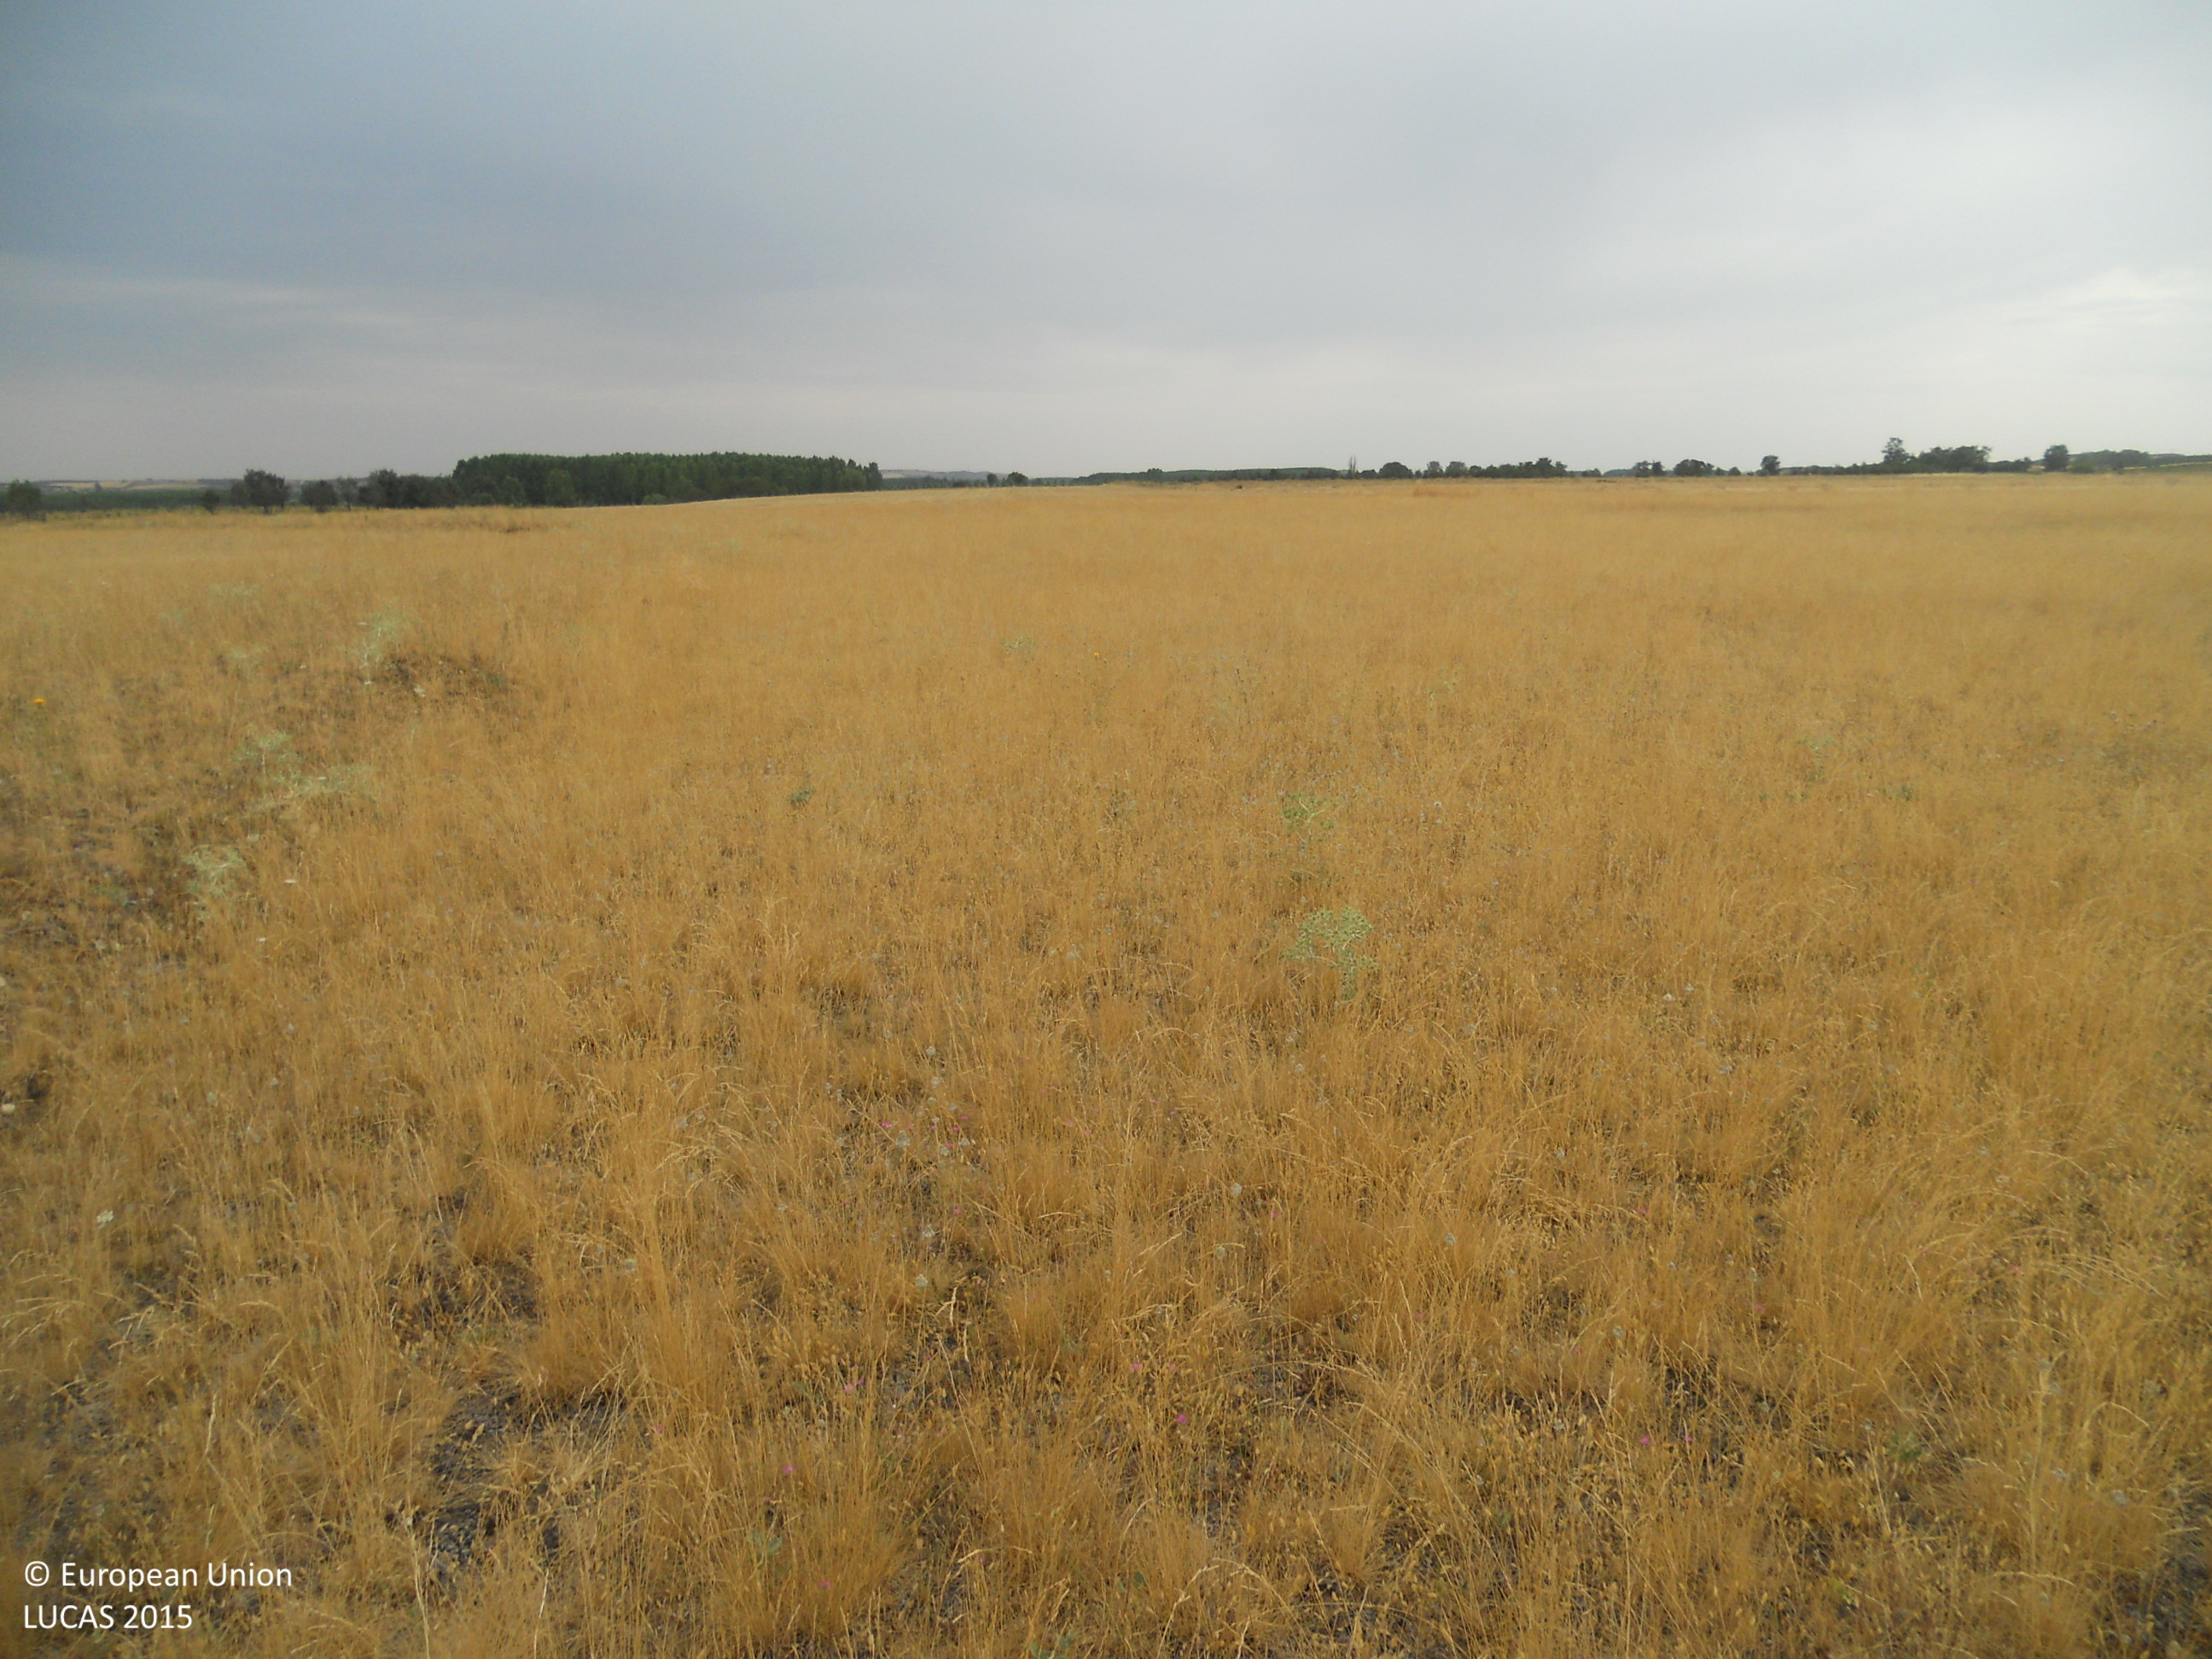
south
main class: Grassland
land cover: Spontaneously vegetated surfaces
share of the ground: > 75 %
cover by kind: herbaceous plants 100 %
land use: Fallow land
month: July
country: ES
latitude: 42.6211
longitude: -5.4197
